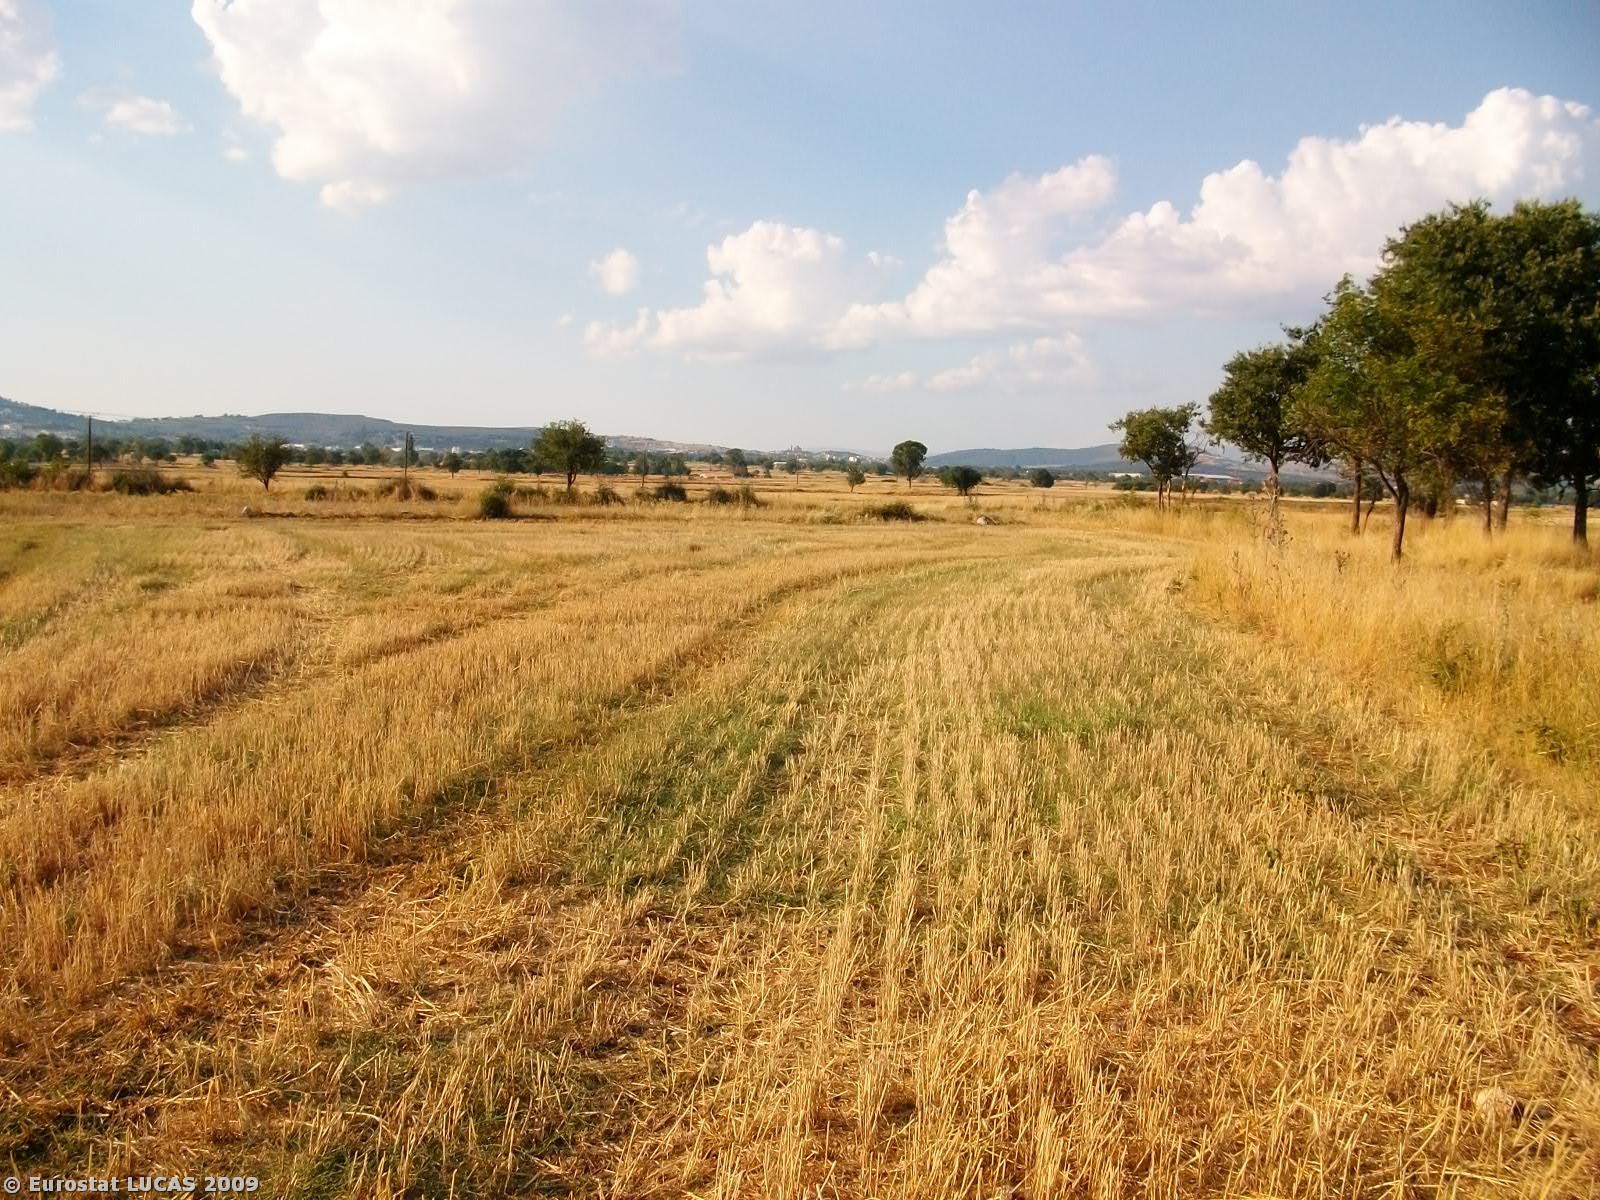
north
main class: Cropland
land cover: Durum wheat
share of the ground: < 10 %
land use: Agriculture (excluding fallow land and kitchen gardens)
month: July
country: GR
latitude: 40.2816
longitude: 21.8124
